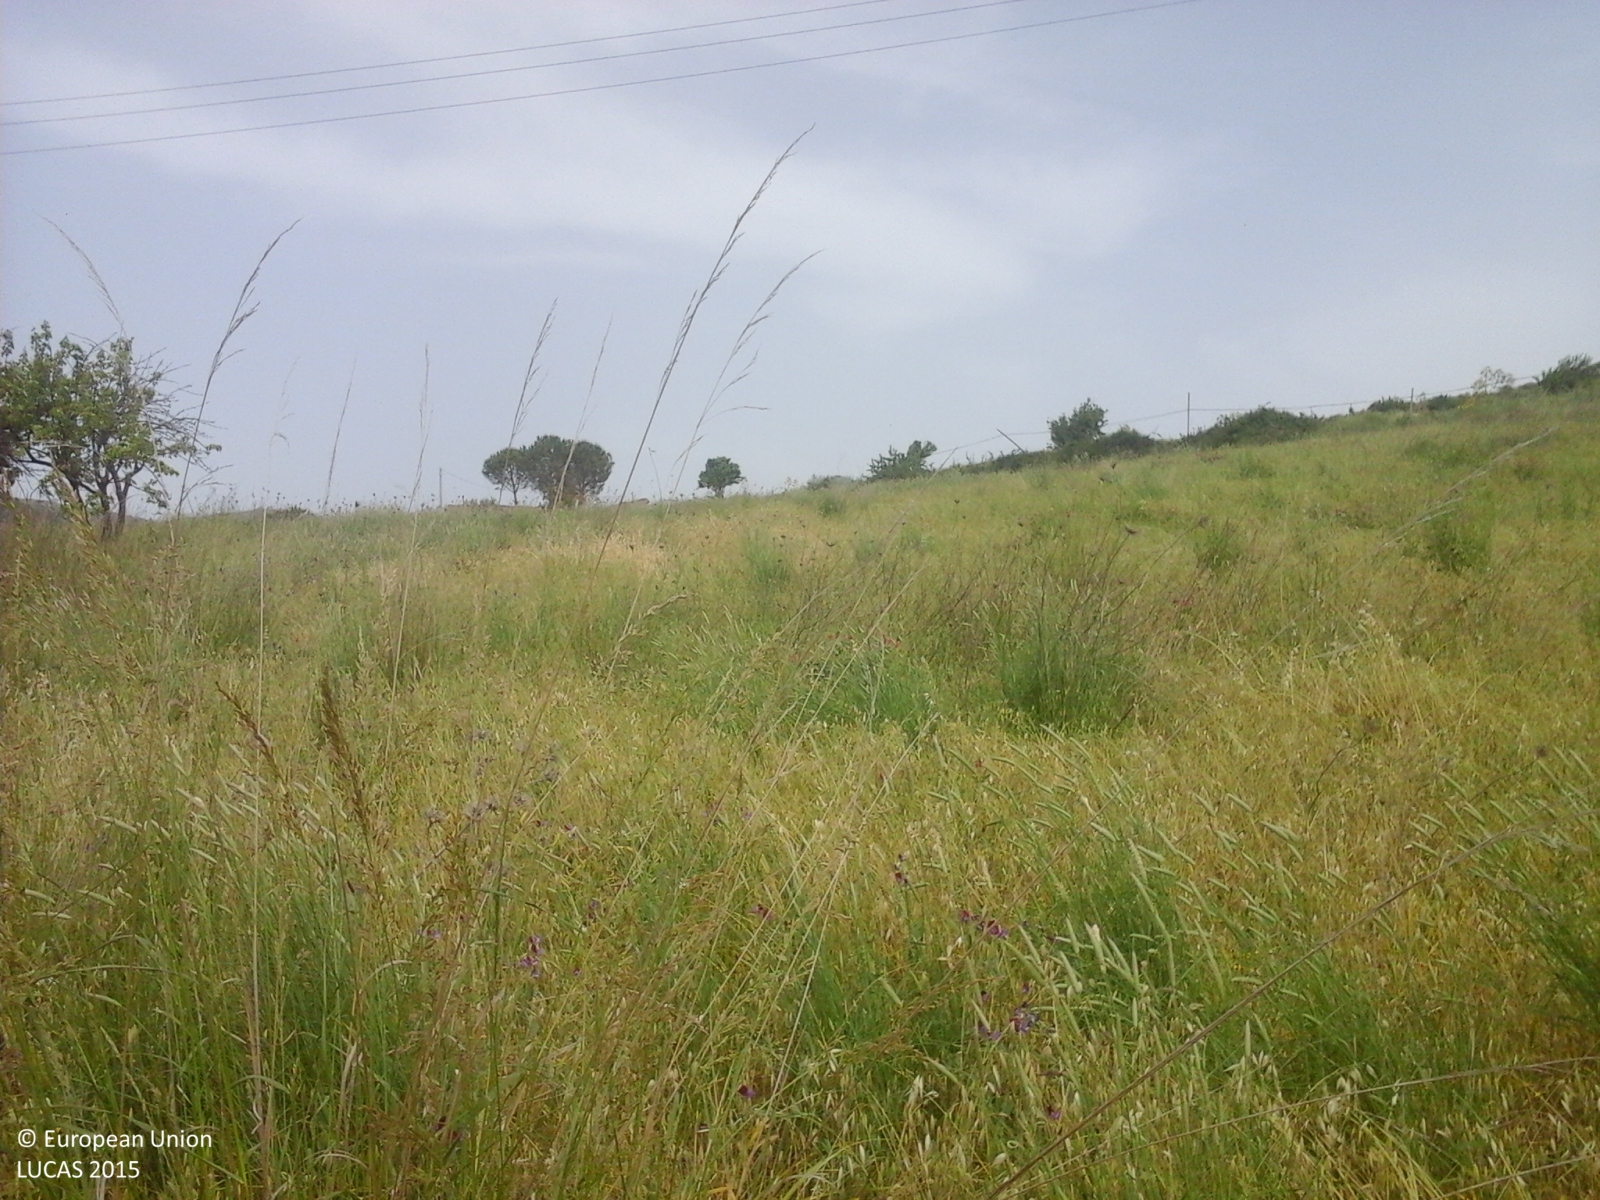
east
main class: Grassland
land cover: Spontaneously vegetated surfaces
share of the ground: > 75 %
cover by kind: herbaceous plants 100 %
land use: Fallow land
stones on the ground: < 10 %
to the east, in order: Spontaneously vegetated surfaces; Single bushes/trees; Spontaneously vegetated surfaces; Grassland without tree/shrub cover; Paved roads, cycling and walking lanes; Artificial constructions; Fences; Olive groves; Fences; Tracks; Fences; Barley; Fences; Shruby margins; Artificial constructions; Paved roads, cycling and walking lanes
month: May
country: IT
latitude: 37.7455
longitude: 14.2030
